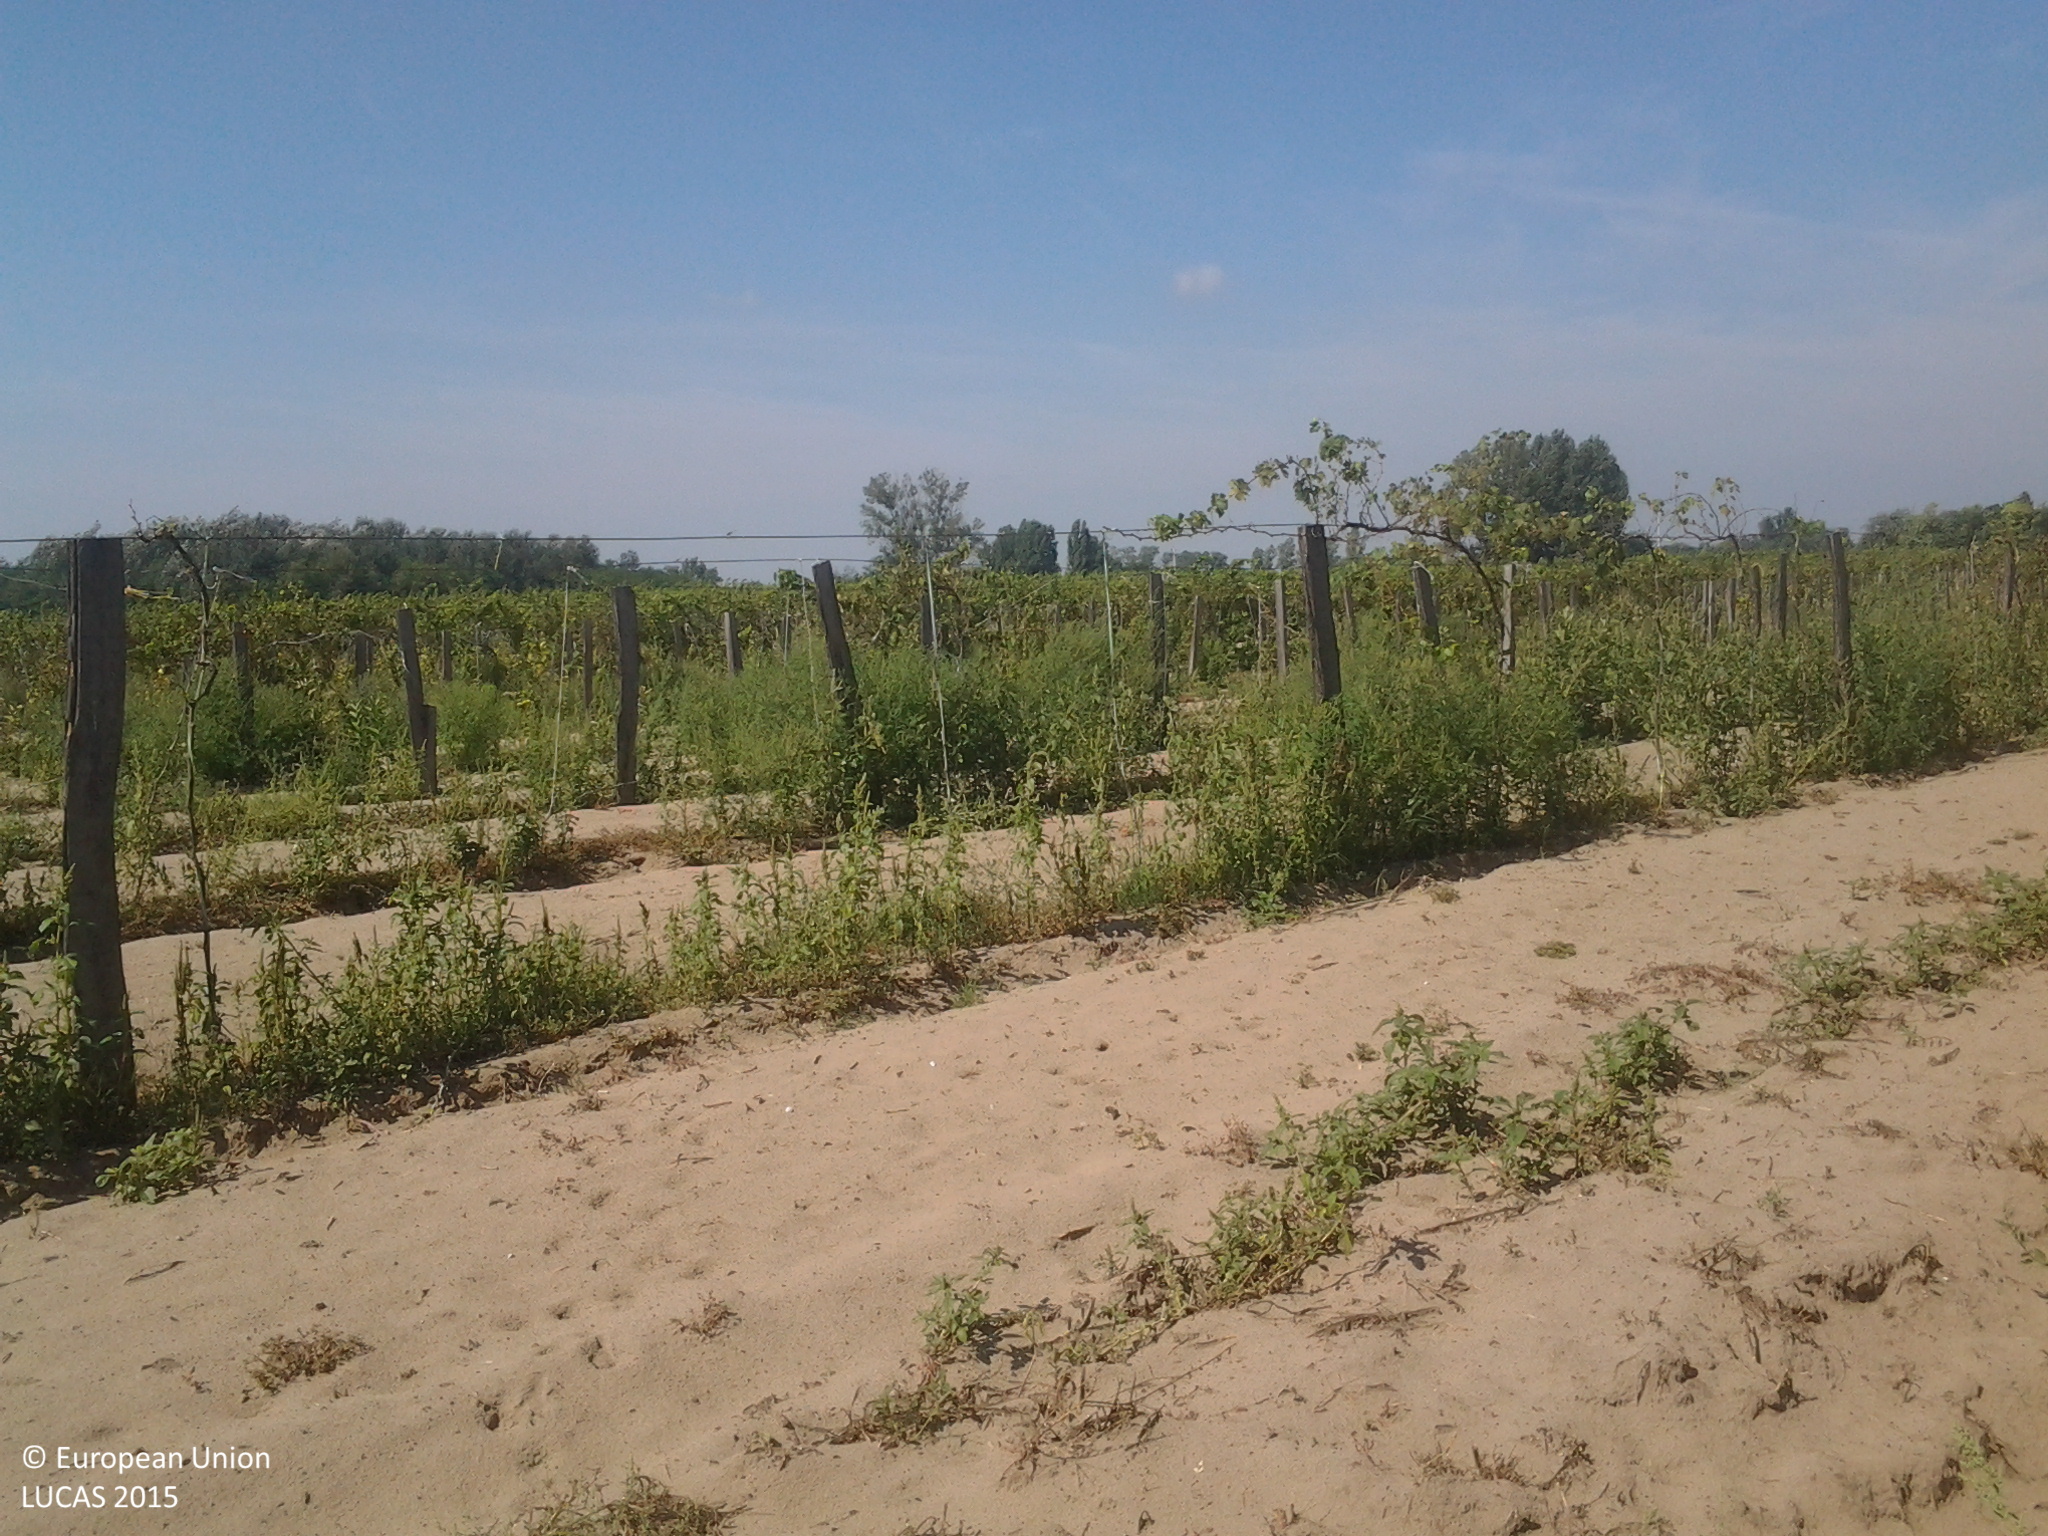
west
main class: Woodland
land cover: Pine dominated coniferous woodland
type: hemiboreal forest and nemoral coniferous forest and mixed broadleaved-coniferous forest
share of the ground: > 75 %
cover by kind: coniferous forest trees 100 %
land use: Forestry
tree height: > 5 m
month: August
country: HU
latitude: 46.7310
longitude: 19.6375
